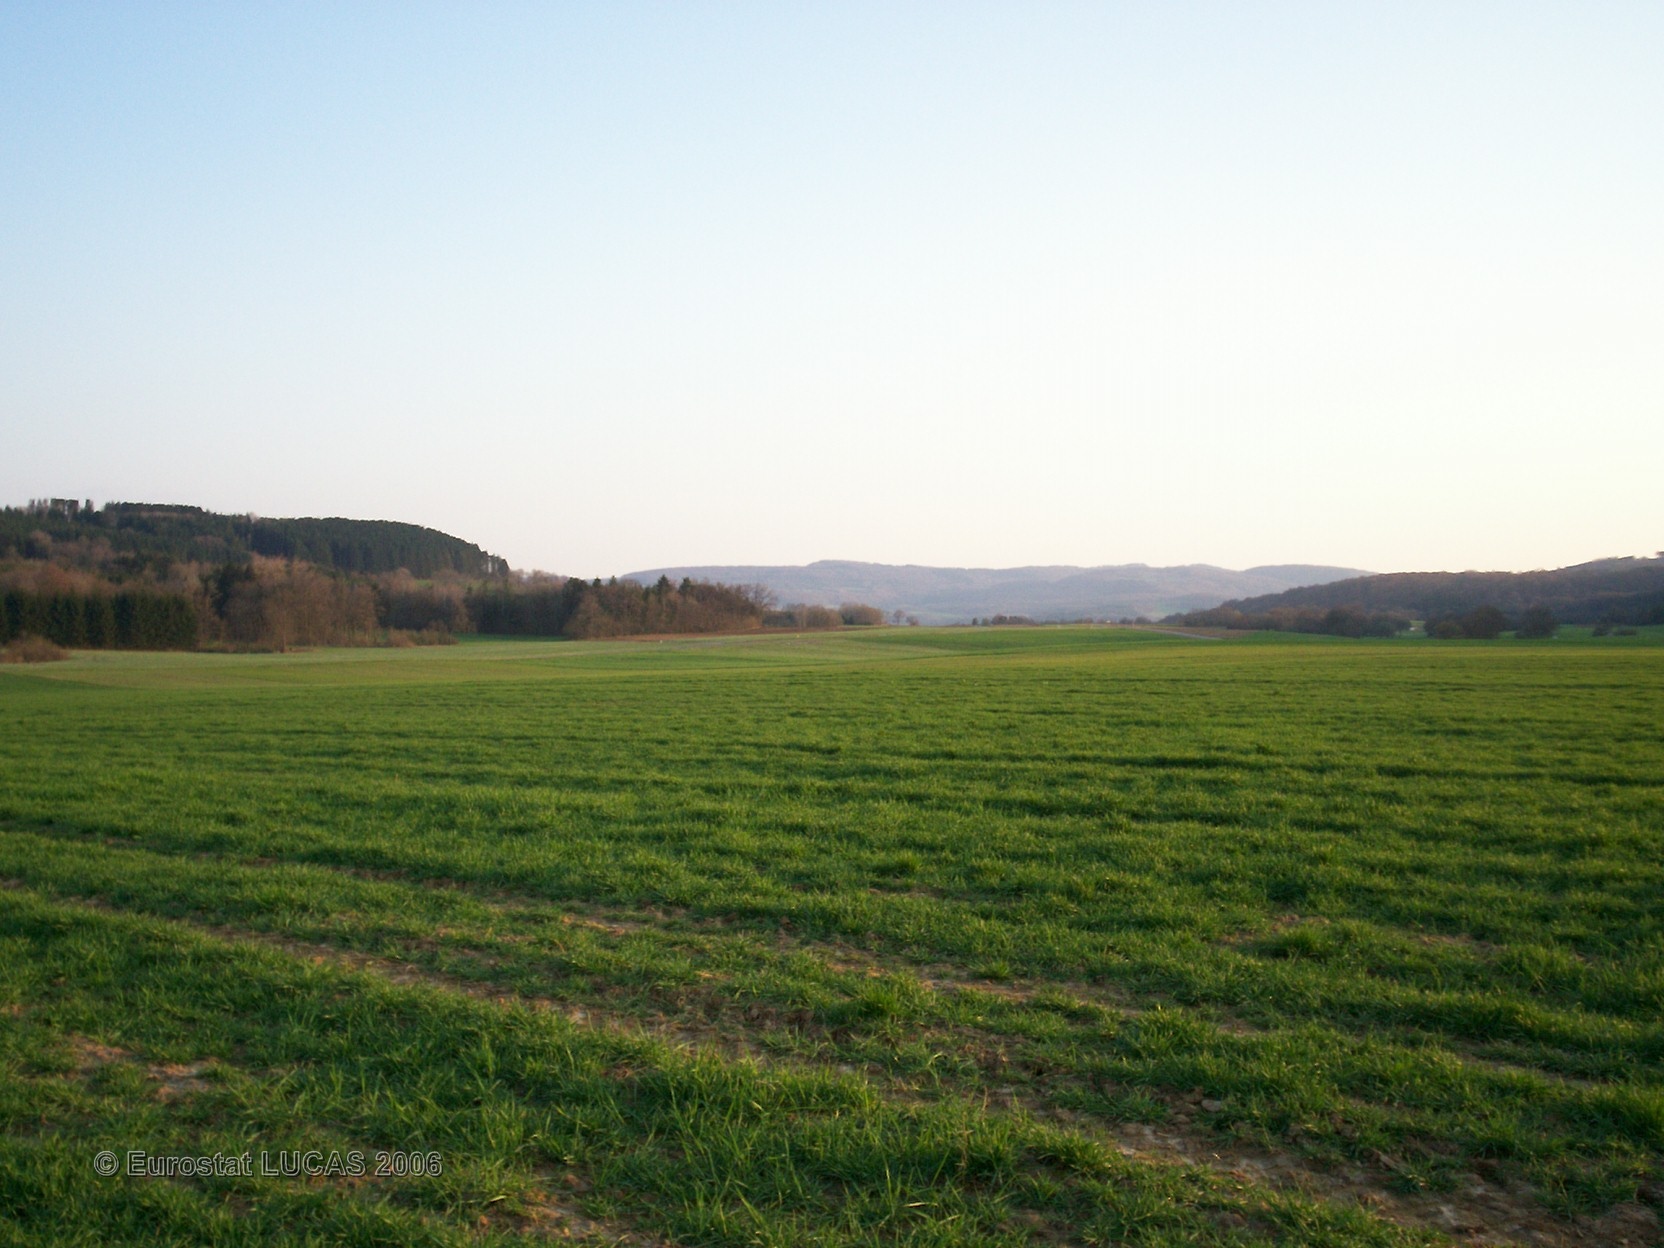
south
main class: Cropland
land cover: Maize
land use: Agriculture (excluding fallow land and kitchen gardens)
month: May
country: FR
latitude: 47.3425
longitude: 6.6003
